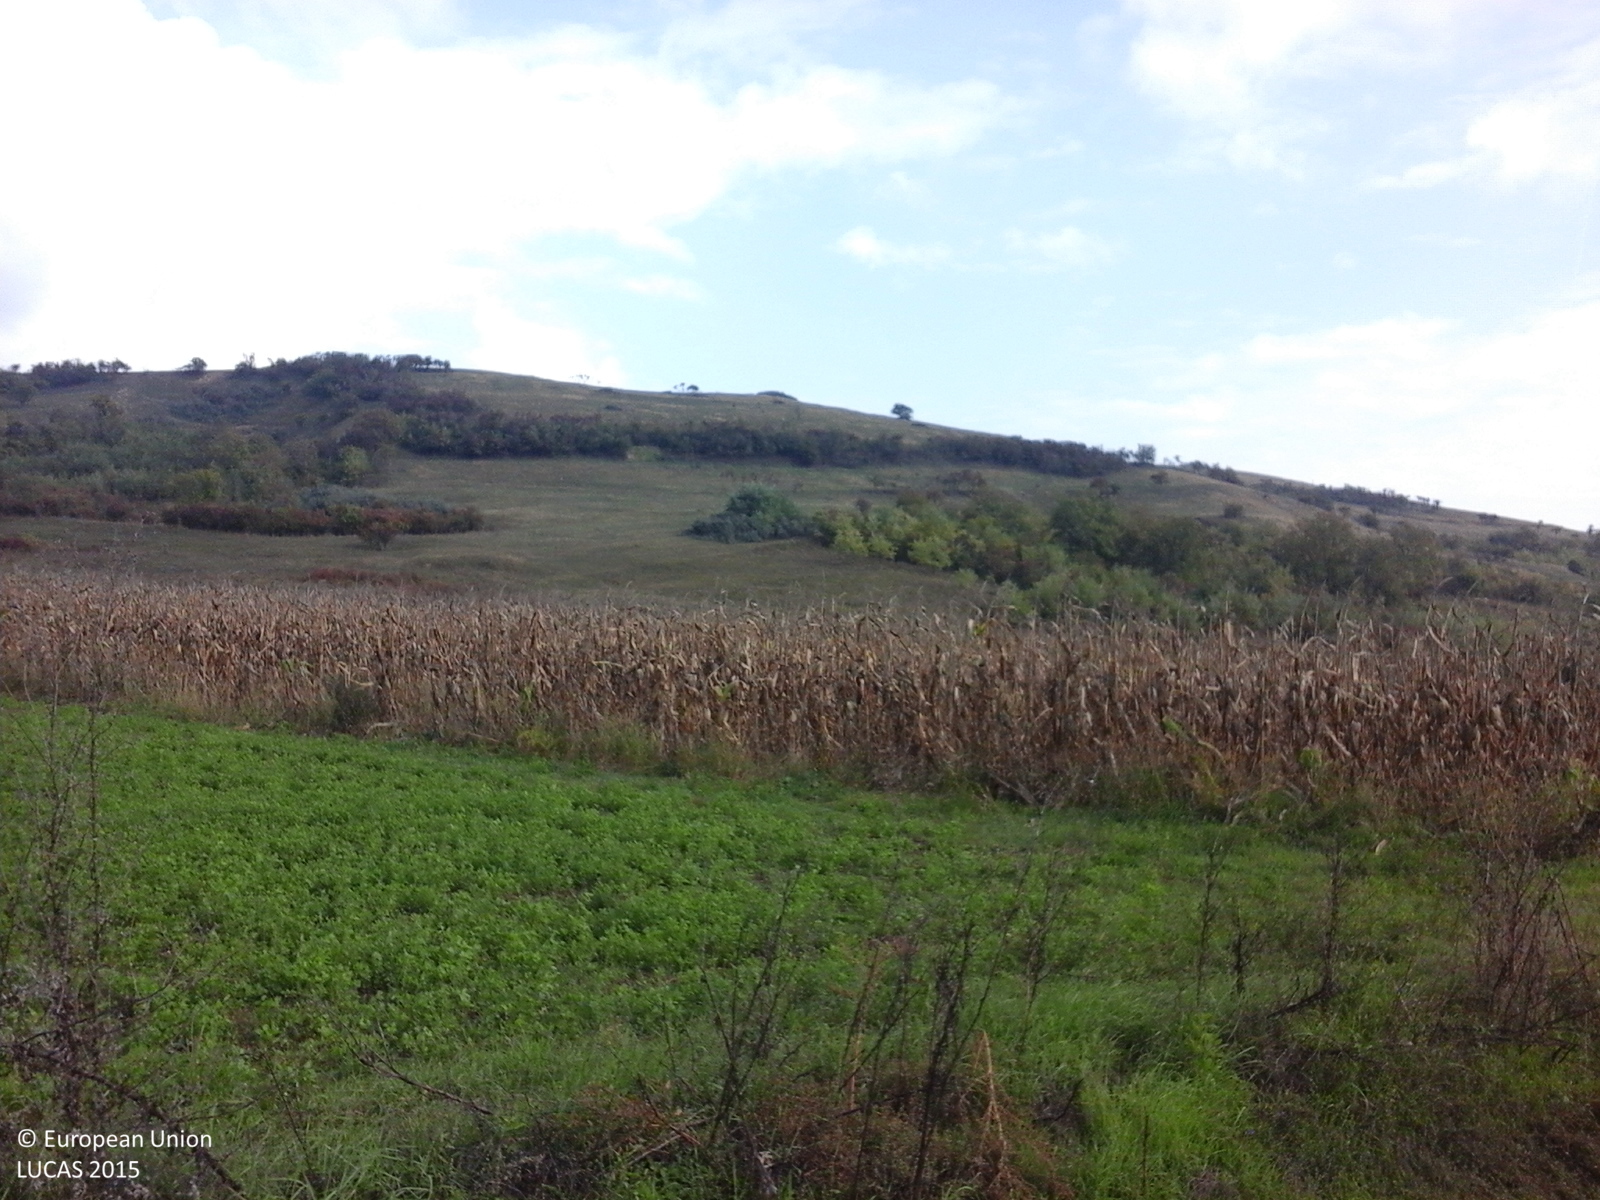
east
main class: Cropland
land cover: Maize
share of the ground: > 75 %
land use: Agriculture (excluding fallow land and kitchen gardens)
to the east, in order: Maize; Tracks; Maize; Lucerne; Grassland without tree/shrub cover
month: October
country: RO
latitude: 46.4045
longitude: 24.3258
